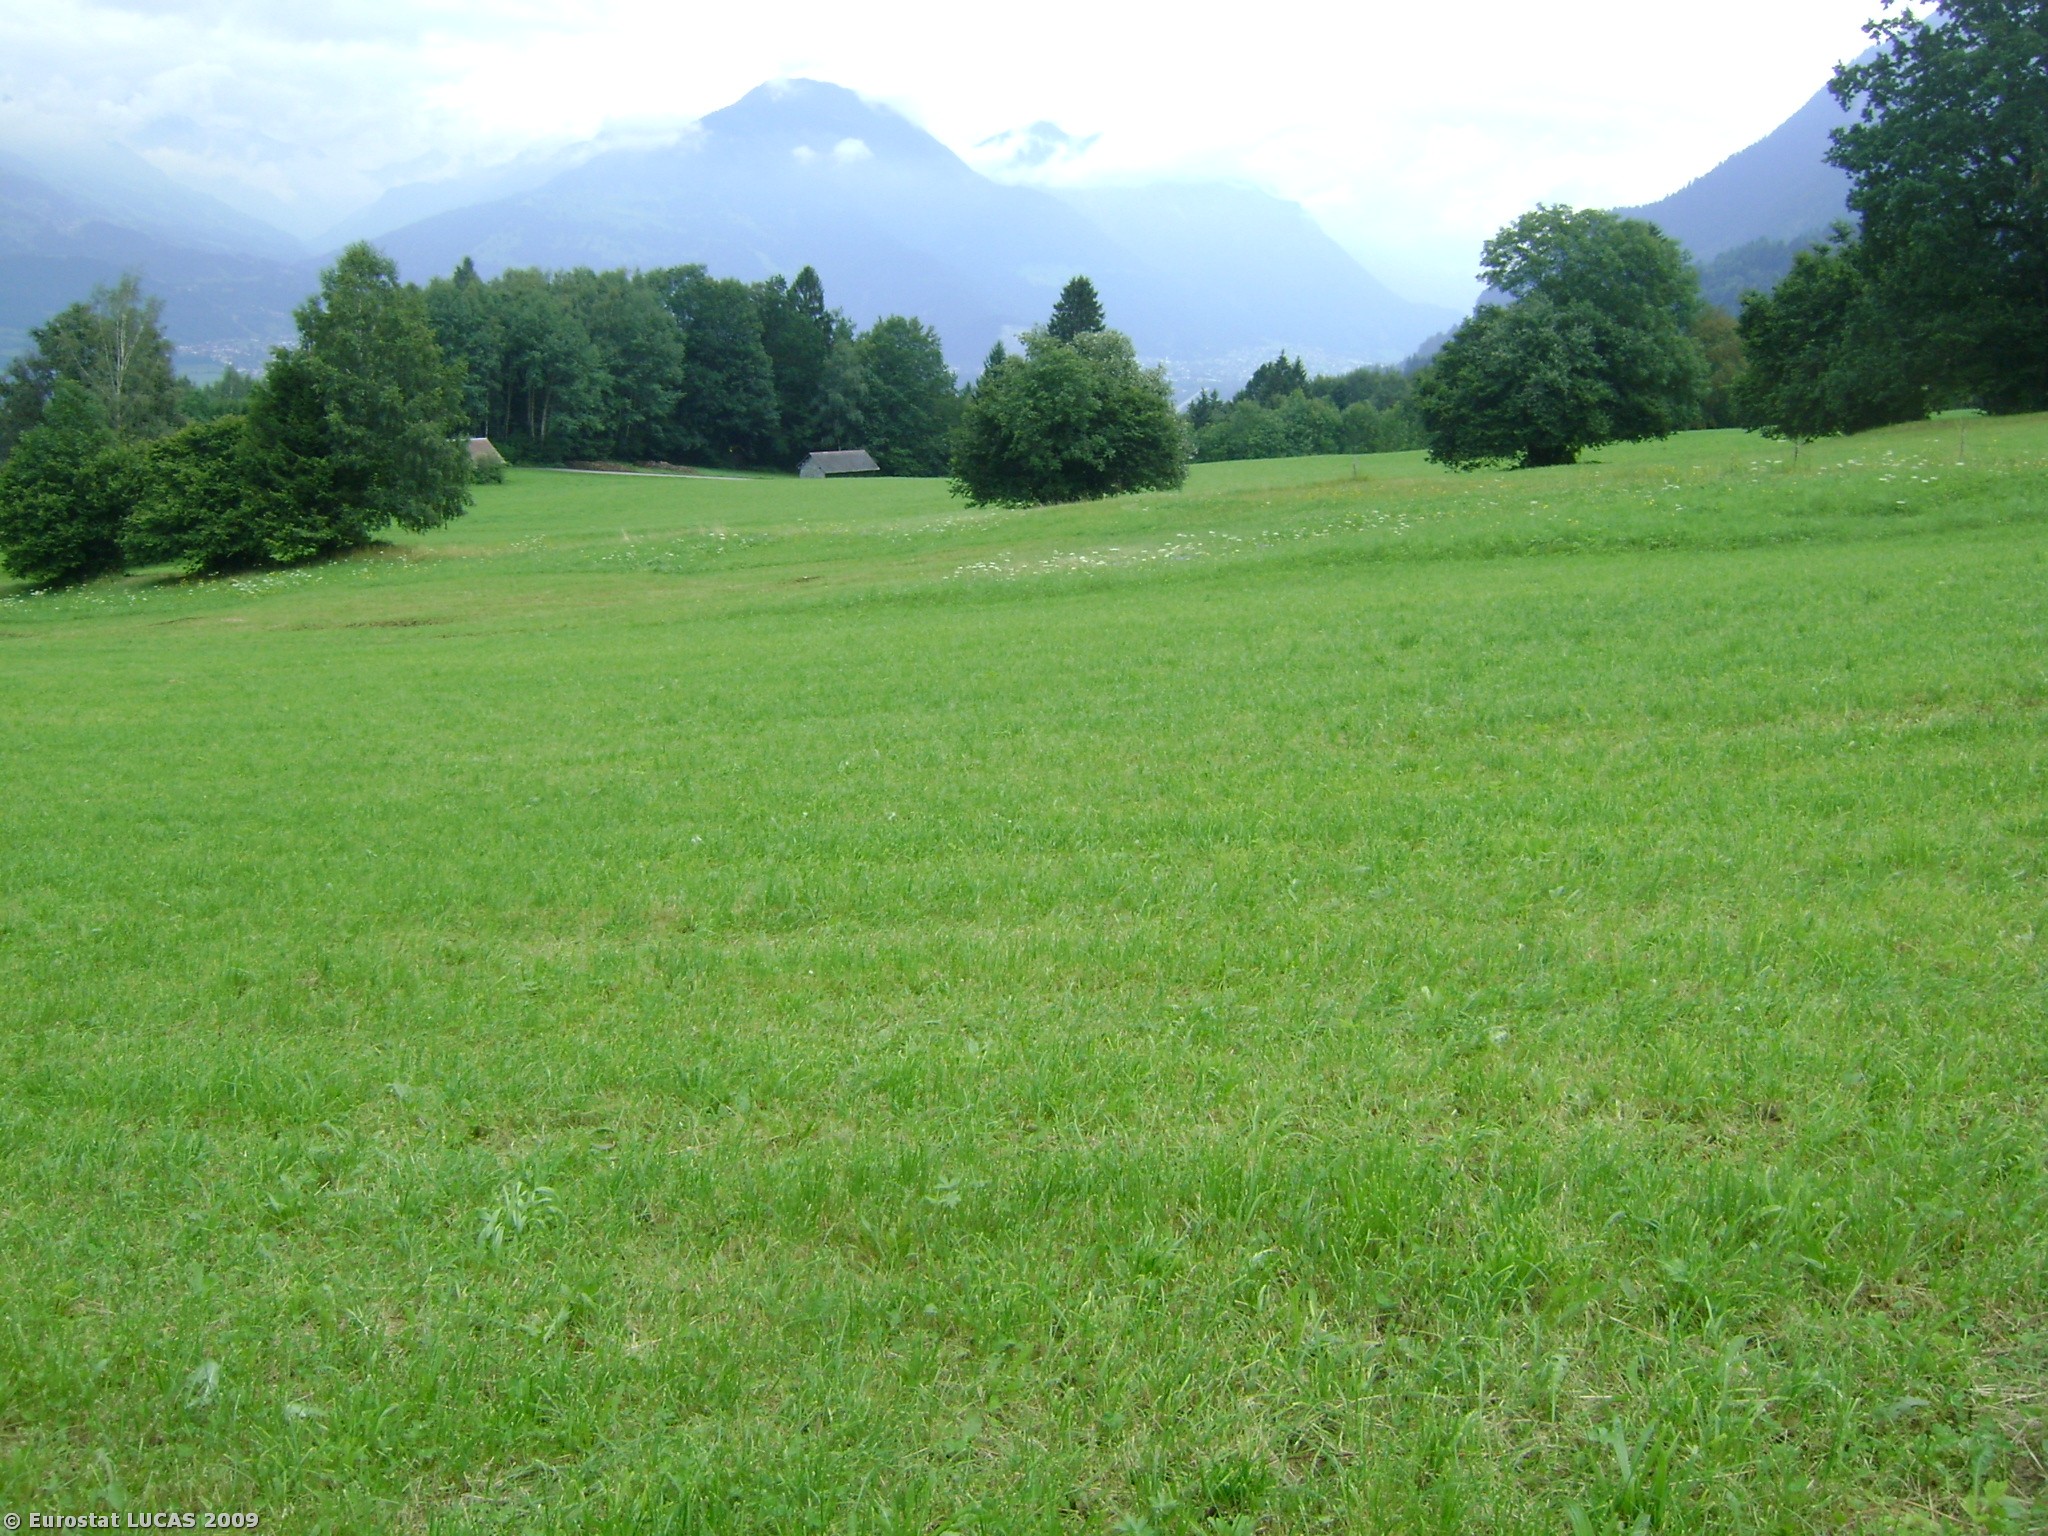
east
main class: Grassland
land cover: Grassland without tree/shrub cover
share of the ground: > 75 %
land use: Agriculture (excluding fallow land and kitchen gardens)
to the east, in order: Grassland without tree/shrub cover; Single bushes/trees; Grassland without tree/shrub cover; Paved roads, cycling and walking lanes
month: August
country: AT
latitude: 47.1791
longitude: 9.6705
